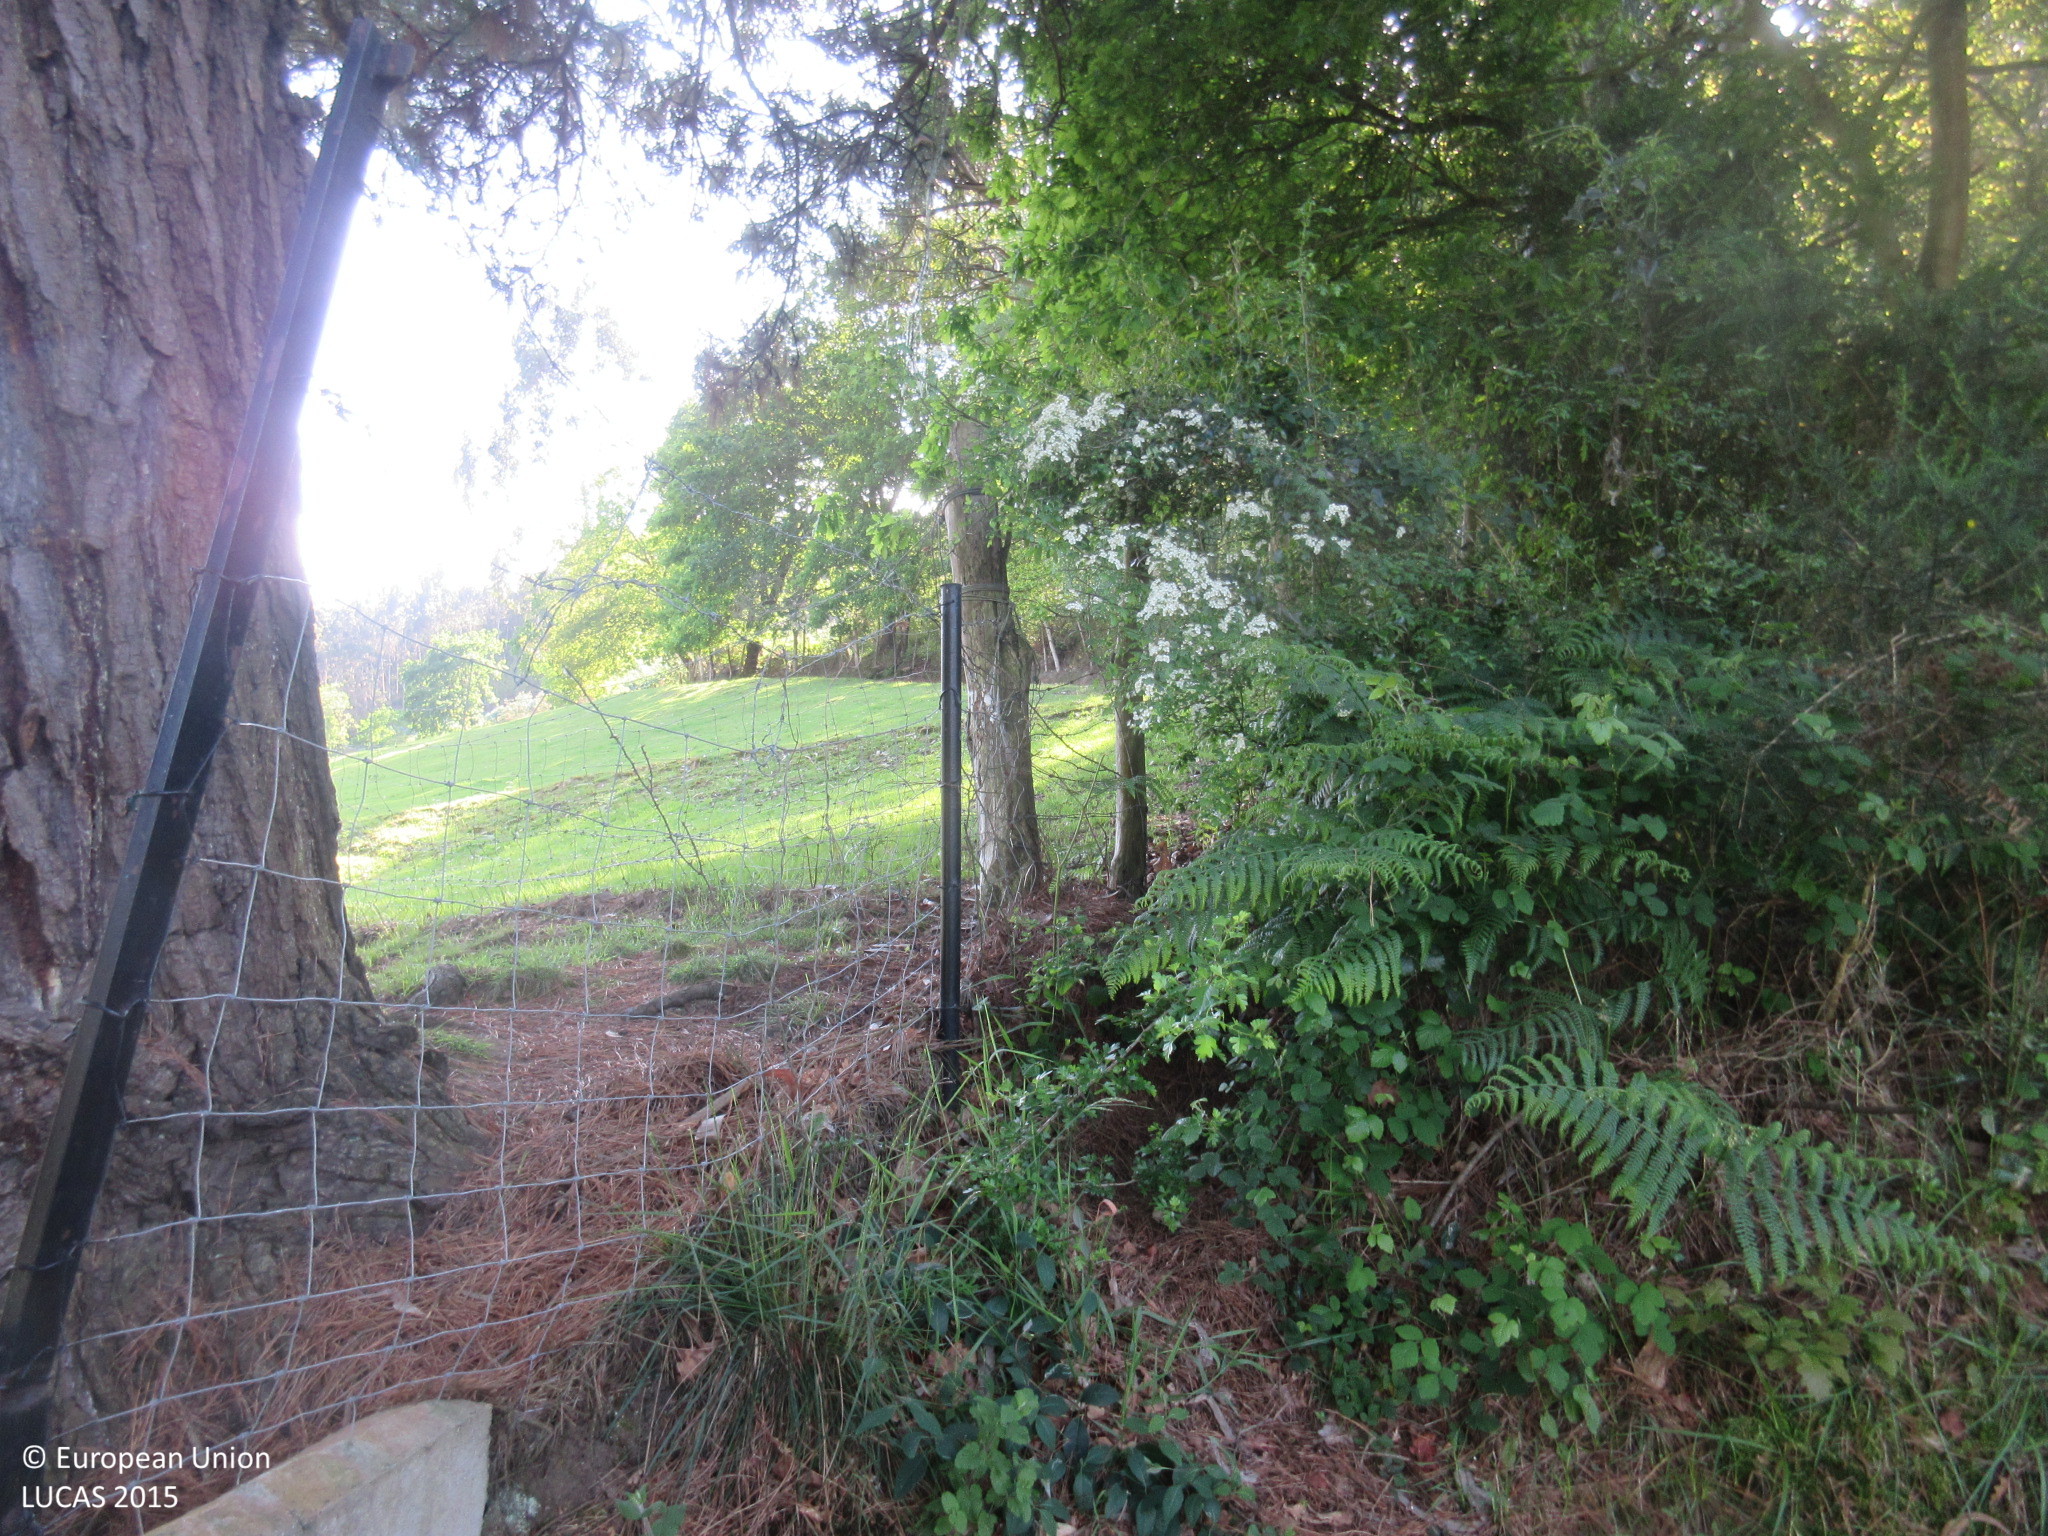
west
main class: Grassland
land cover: Grassland with sparse tree/shrub cover
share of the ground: > 75 %
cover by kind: herbaceous plants 95 %, broadleaved forest trees 5 %
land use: Agriculture (excluding fallow land and kitchen gardens)
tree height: > 5 m
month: May
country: ES
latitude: 43.5368
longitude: -6.0202
